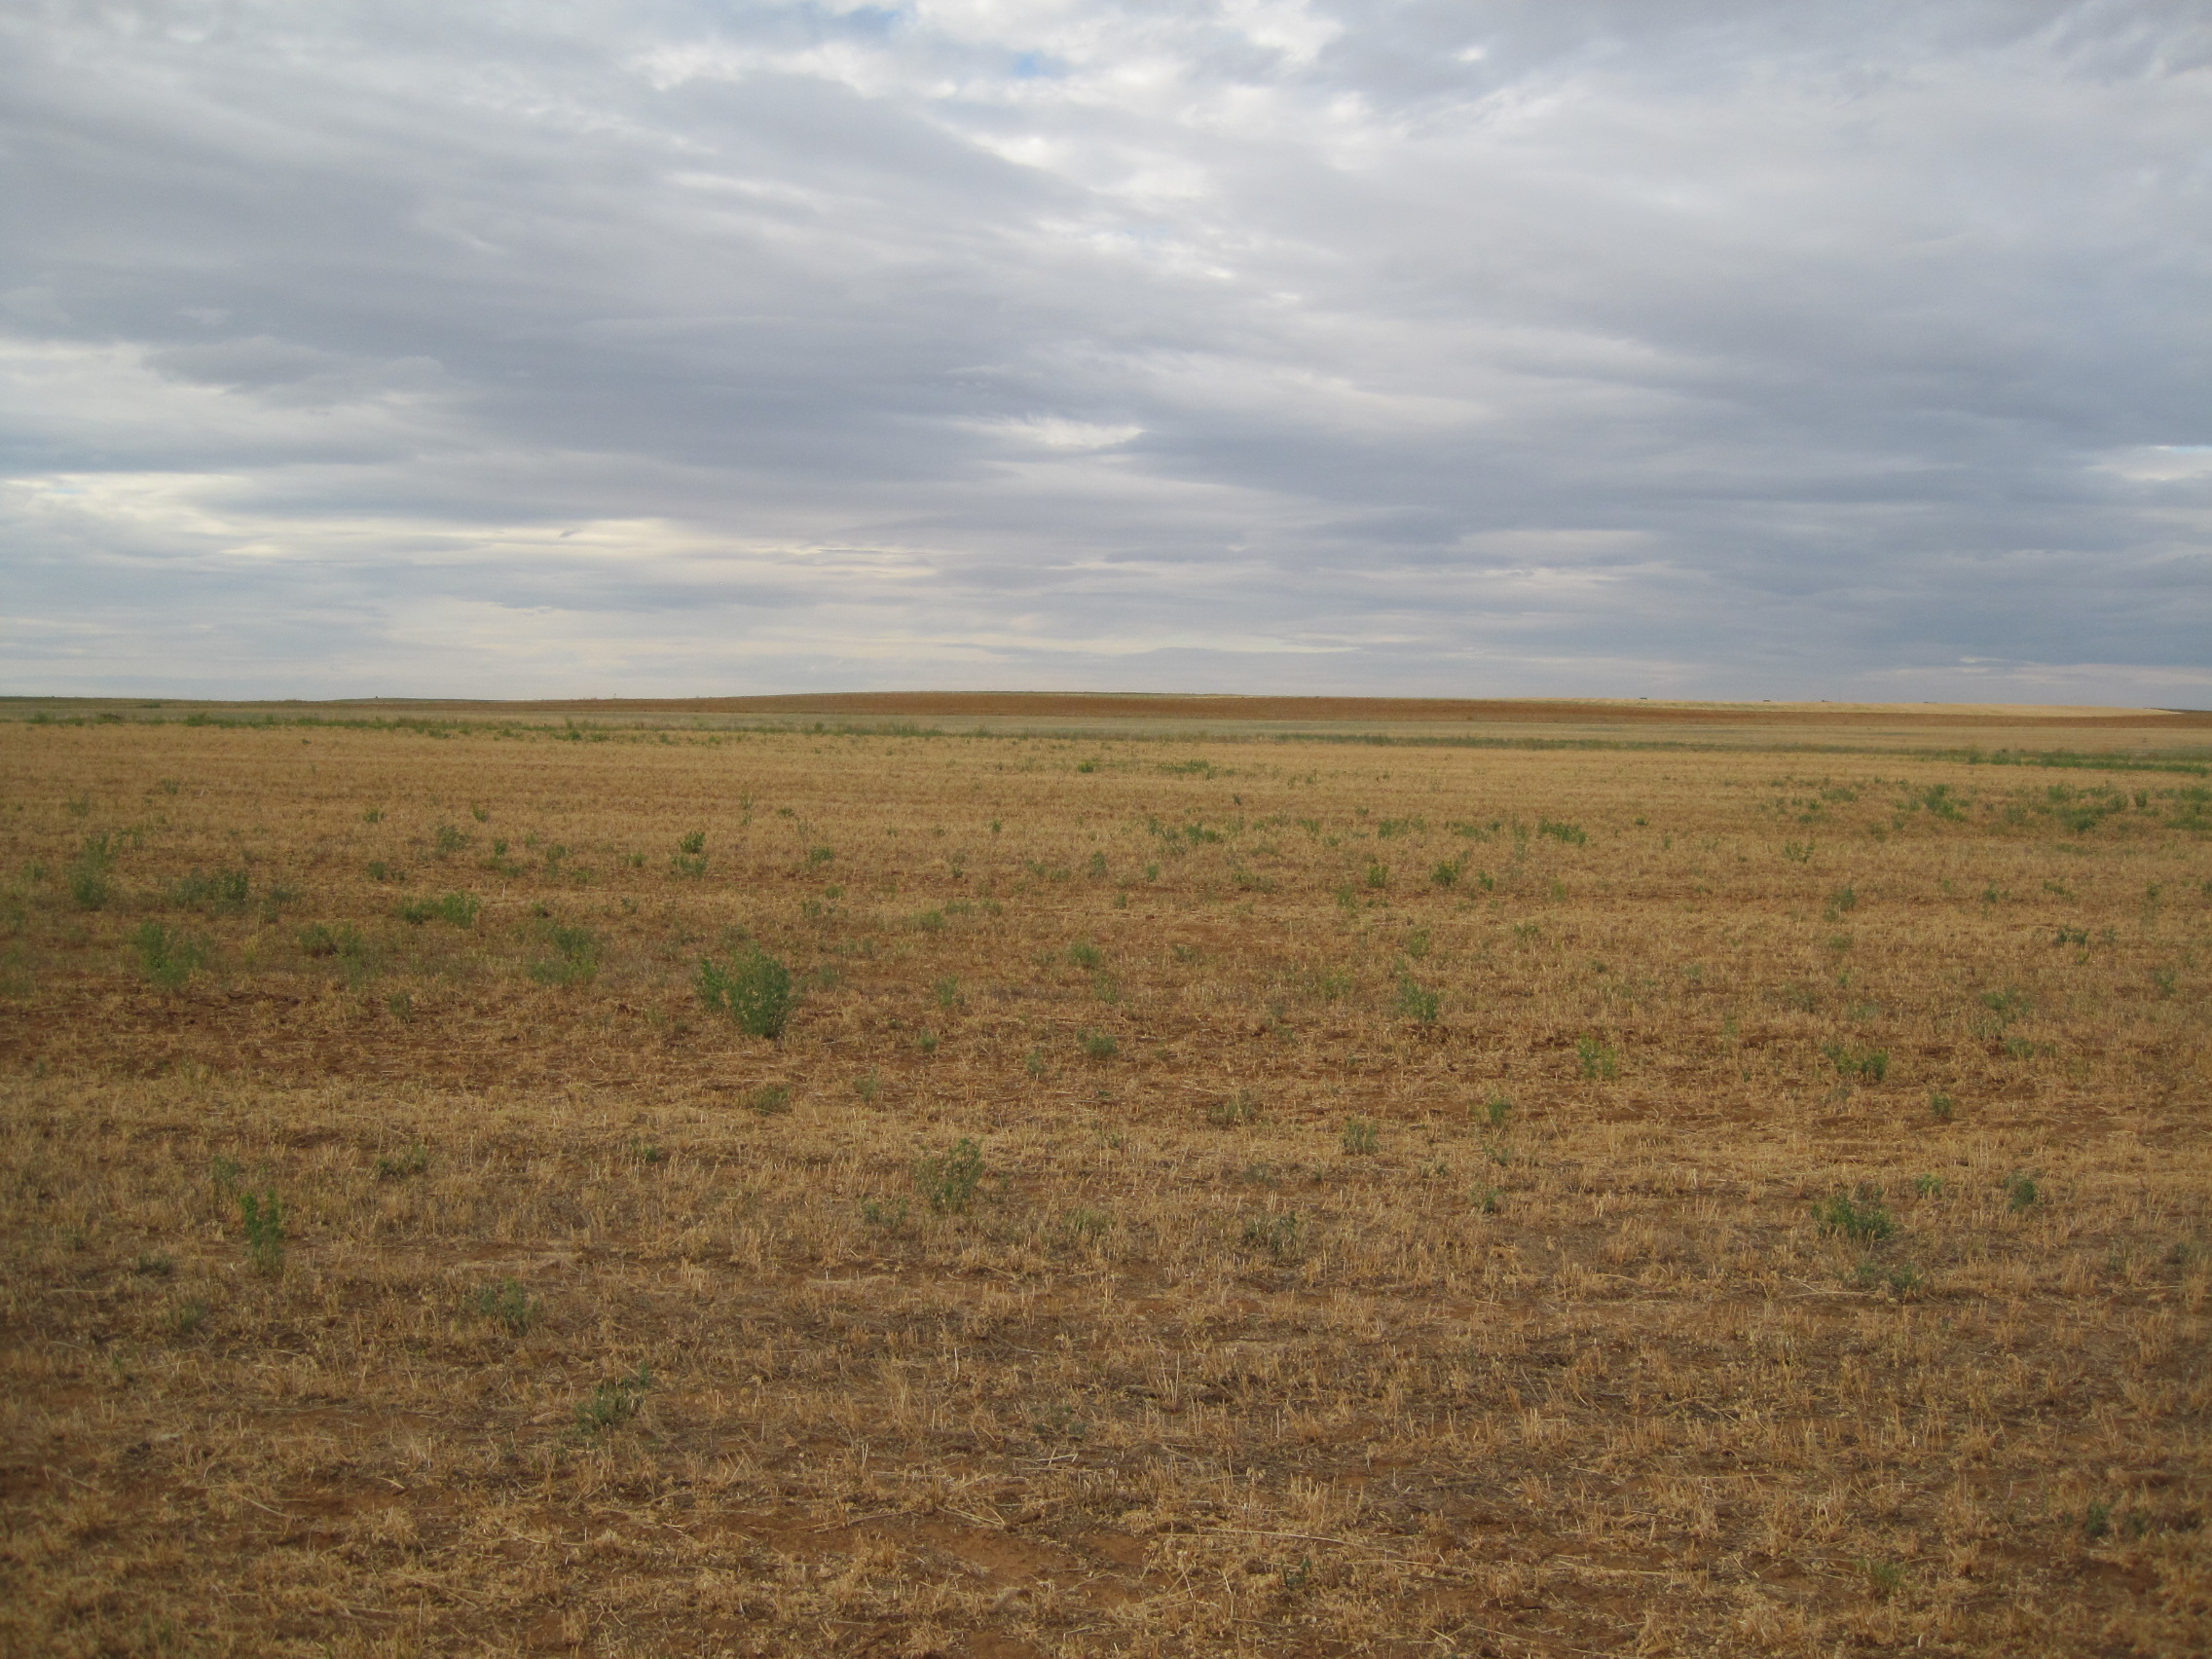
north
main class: Cropland
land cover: Lucerne
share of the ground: < 10 %
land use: Agriculture (excluding fallow land and kitchen gardens)
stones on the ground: 10 - 25 %
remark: Harvested field
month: July
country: ES
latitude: 41.9390
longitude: -5.4402
